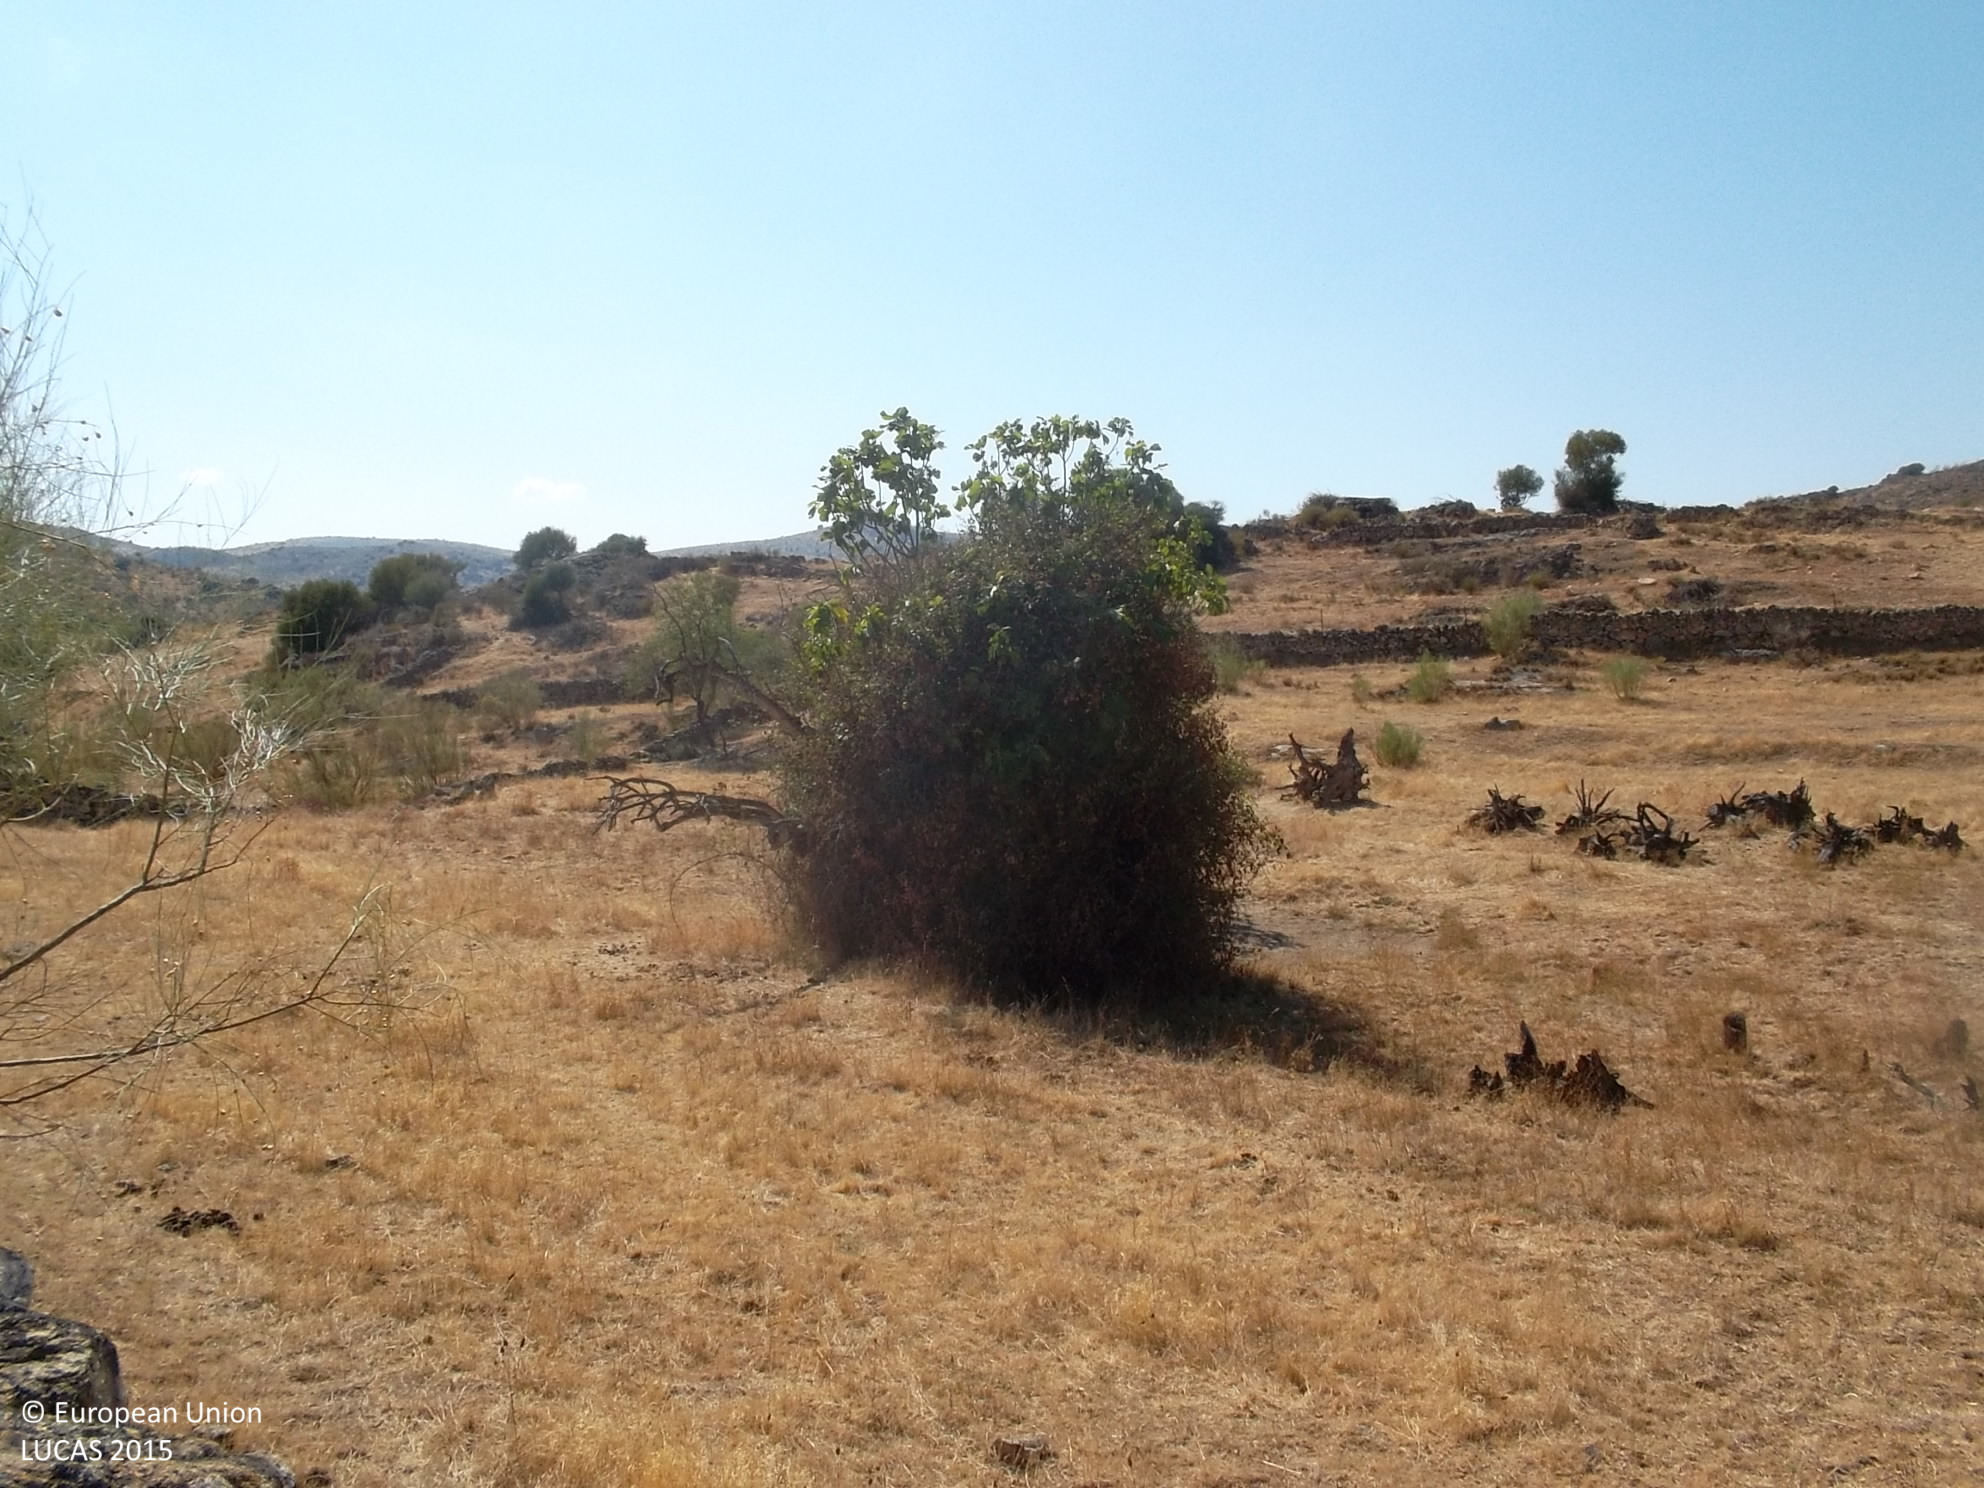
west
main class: Shrubland
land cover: Shrubland with sparse tree cover
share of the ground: > 75 %
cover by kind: herbaceous plants 50 %, shrubs 45 %, broadleaved forest trees 5 %
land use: Agriculture (excluding fallow land and kitchen gardens)
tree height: < 5 m
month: September
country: ES
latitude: 38.2662
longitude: -6.5193
